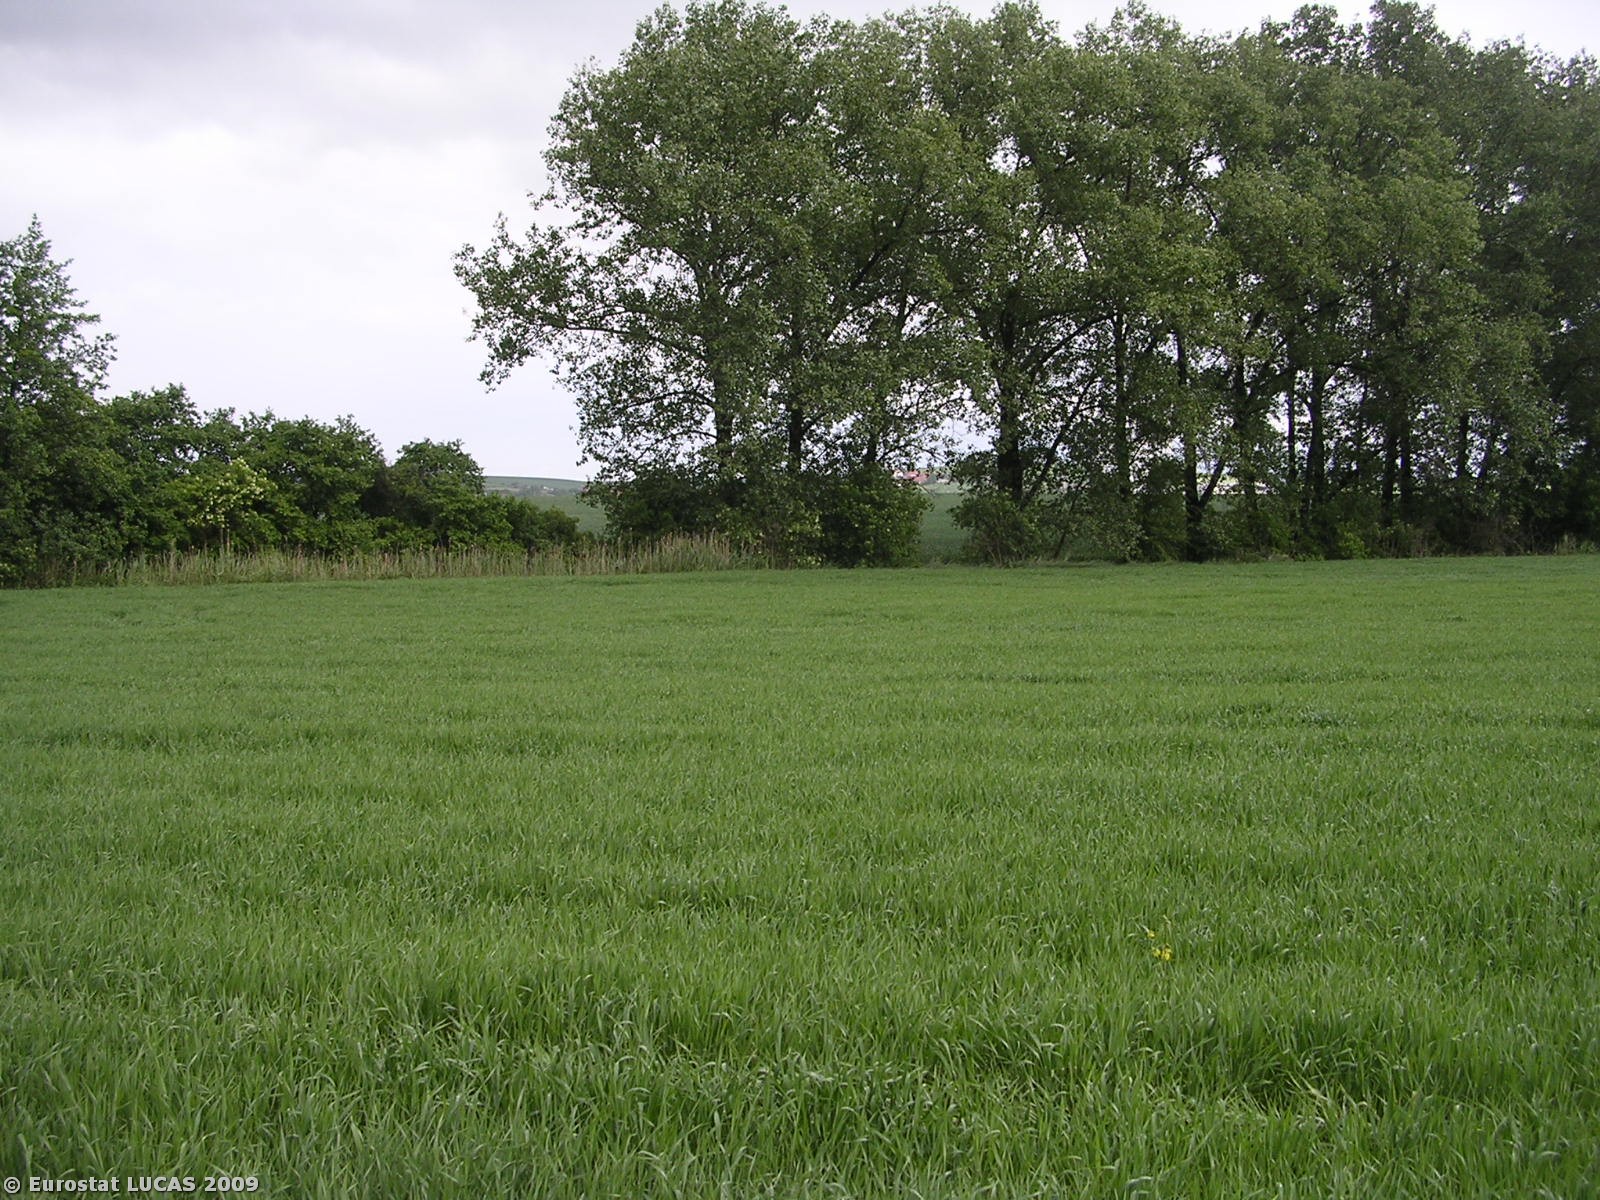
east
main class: Cropland
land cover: Barley
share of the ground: > 75 %
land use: Agriculture (excluding fallow land and kitchen gardens)
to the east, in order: Barley; Grass margins; Ditches and canals; Broadleaved woodland; Common wheat
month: May
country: CZ
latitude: 50.2681
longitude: 14.2242
